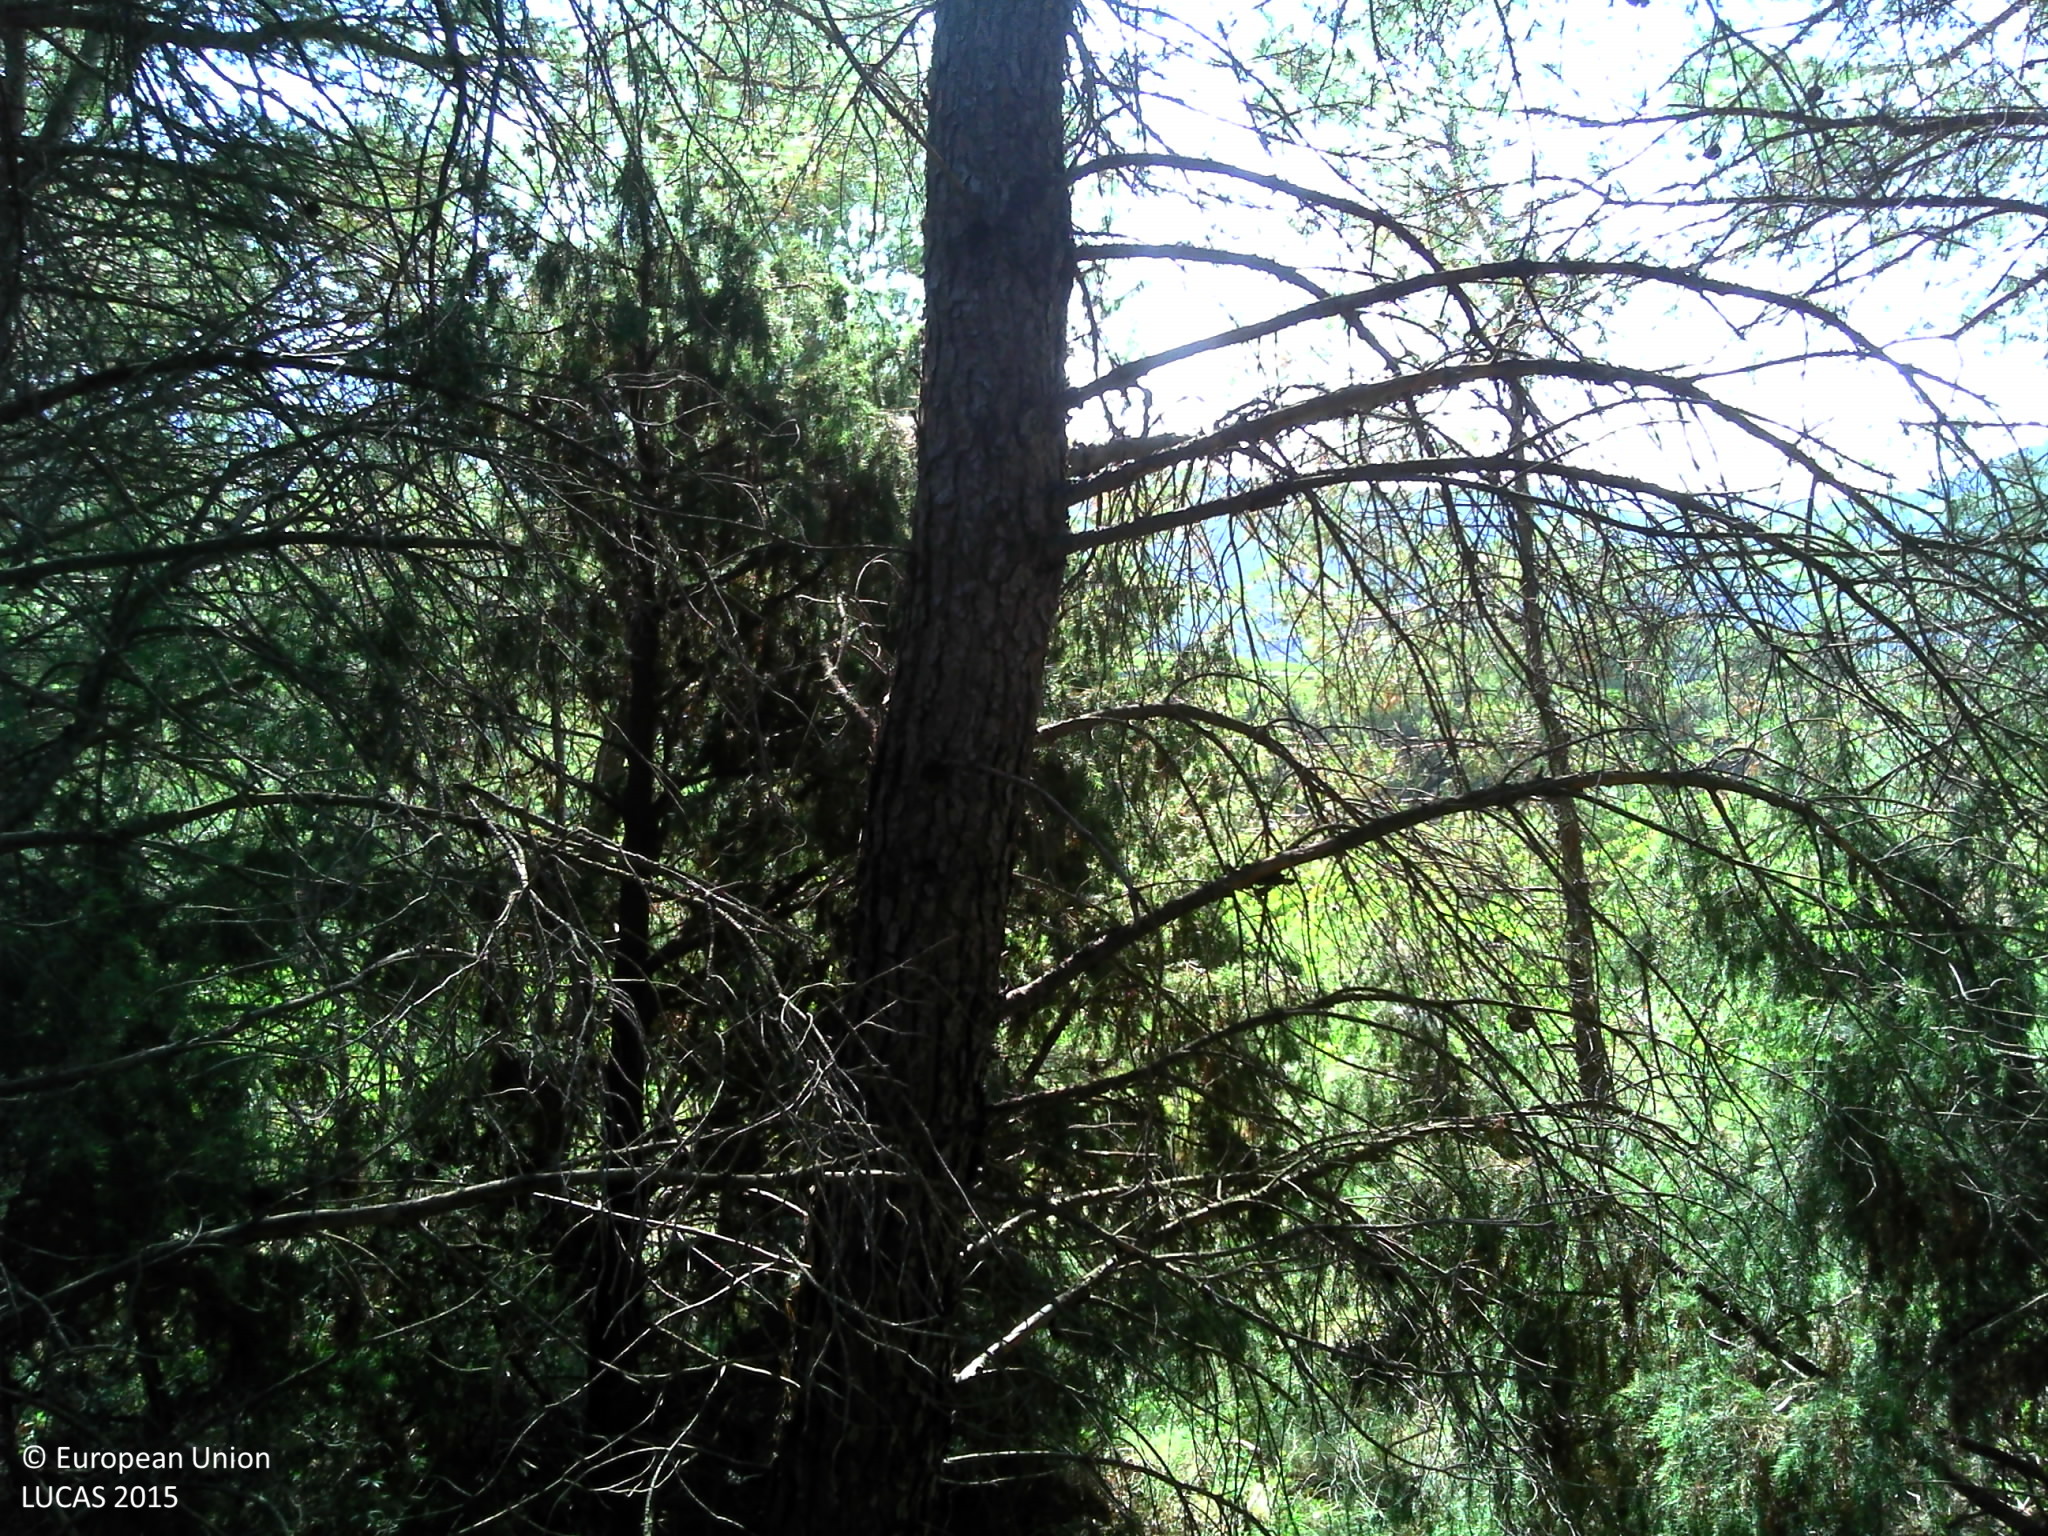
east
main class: Woodland
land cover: Pine dominated mixed woodland
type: mesophytic deciduous forest
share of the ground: > 75 %
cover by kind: coniferous forest trees 40 %, broadleaved forest trees 30 %, shrubs 10 %, herbaceous plants 10 %, lichens and mosses 10 %
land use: Semi-natural and natural areas not in use
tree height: > 5 m
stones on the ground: < 10 %
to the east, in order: Pine dominated mixed woodland; Ditches and canals; Tracks; Managed hedges; Vineyards; Abandoned hedges; Tracks; Olive groves; Pine dominated mixed woodland; Shrubland without tree cover; Pine dominated mixed woodland
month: July
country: FR
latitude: 44.1611
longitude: 5.0686
